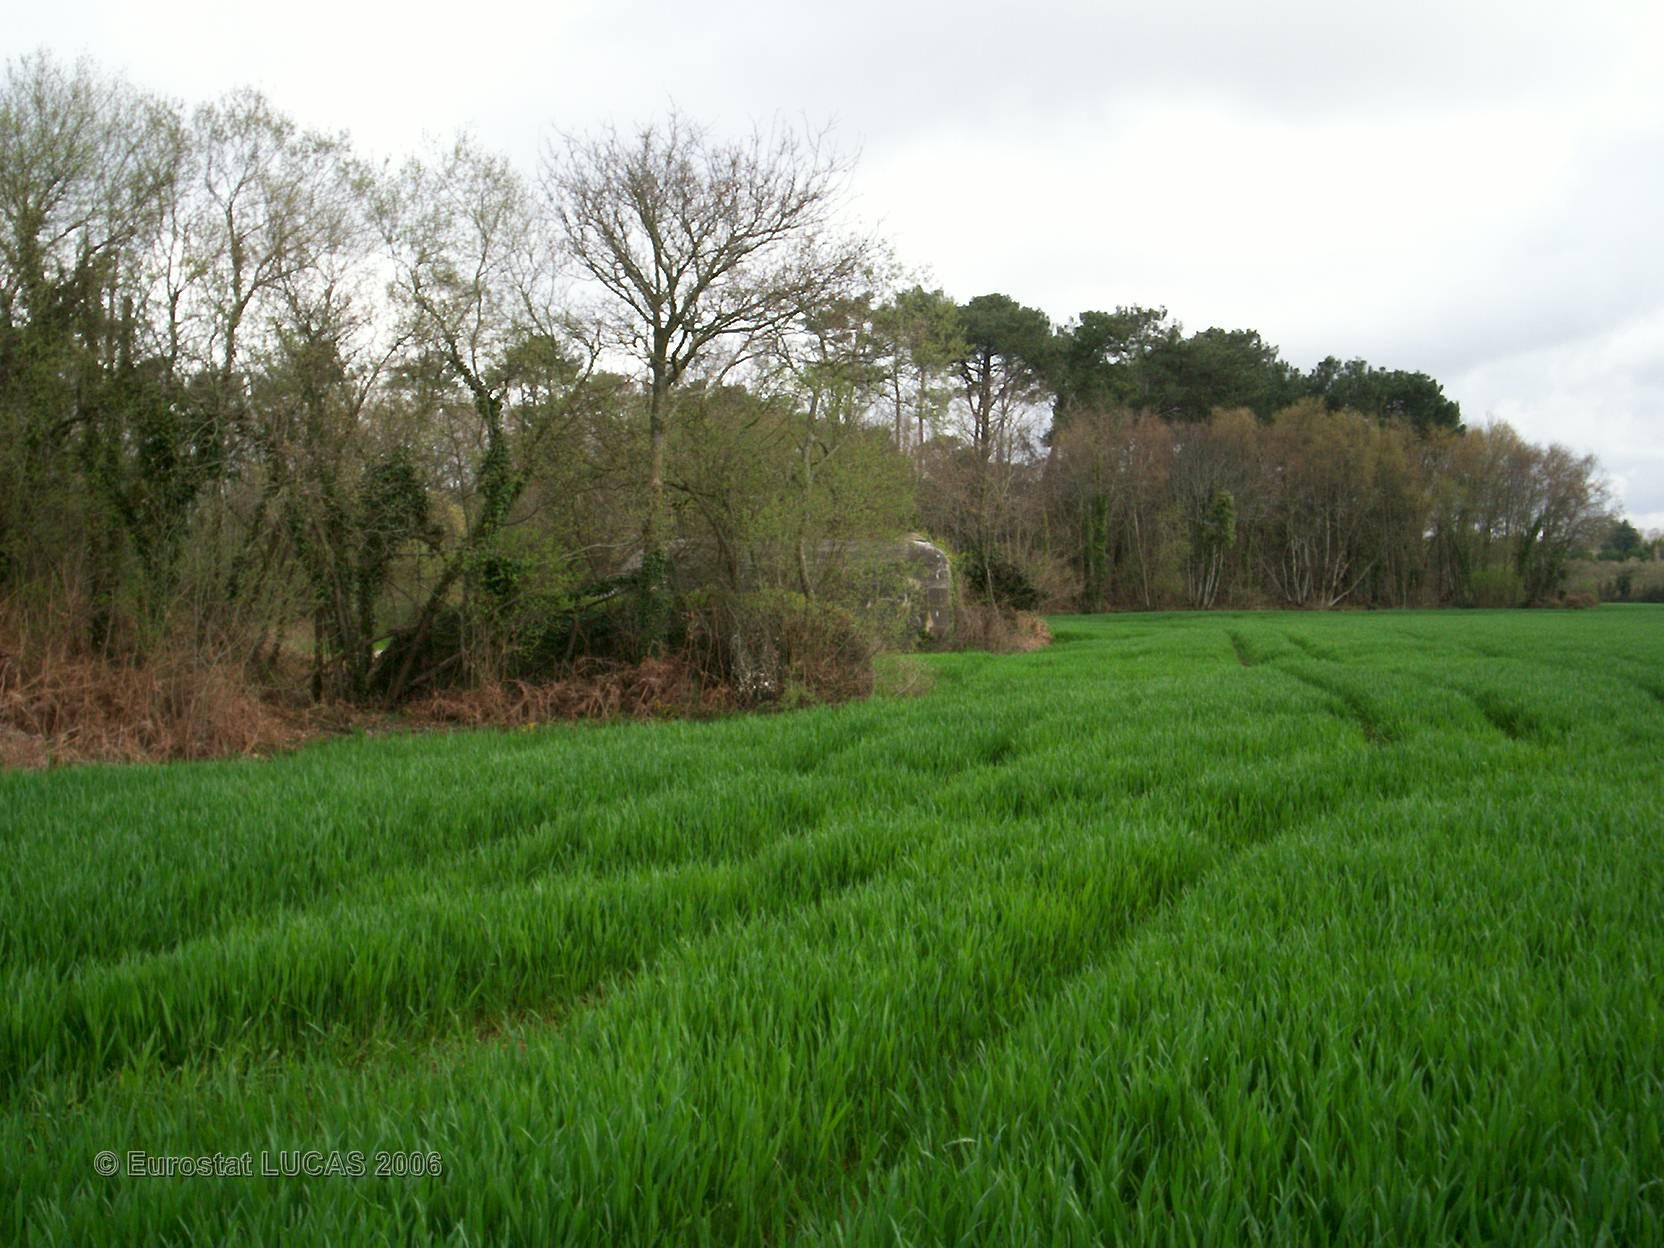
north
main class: Cropland
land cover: Triticale
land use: Agriculture (excluding fallow land and kitchen gardens)
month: April
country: FR
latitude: 47.7412
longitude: -3.4505
